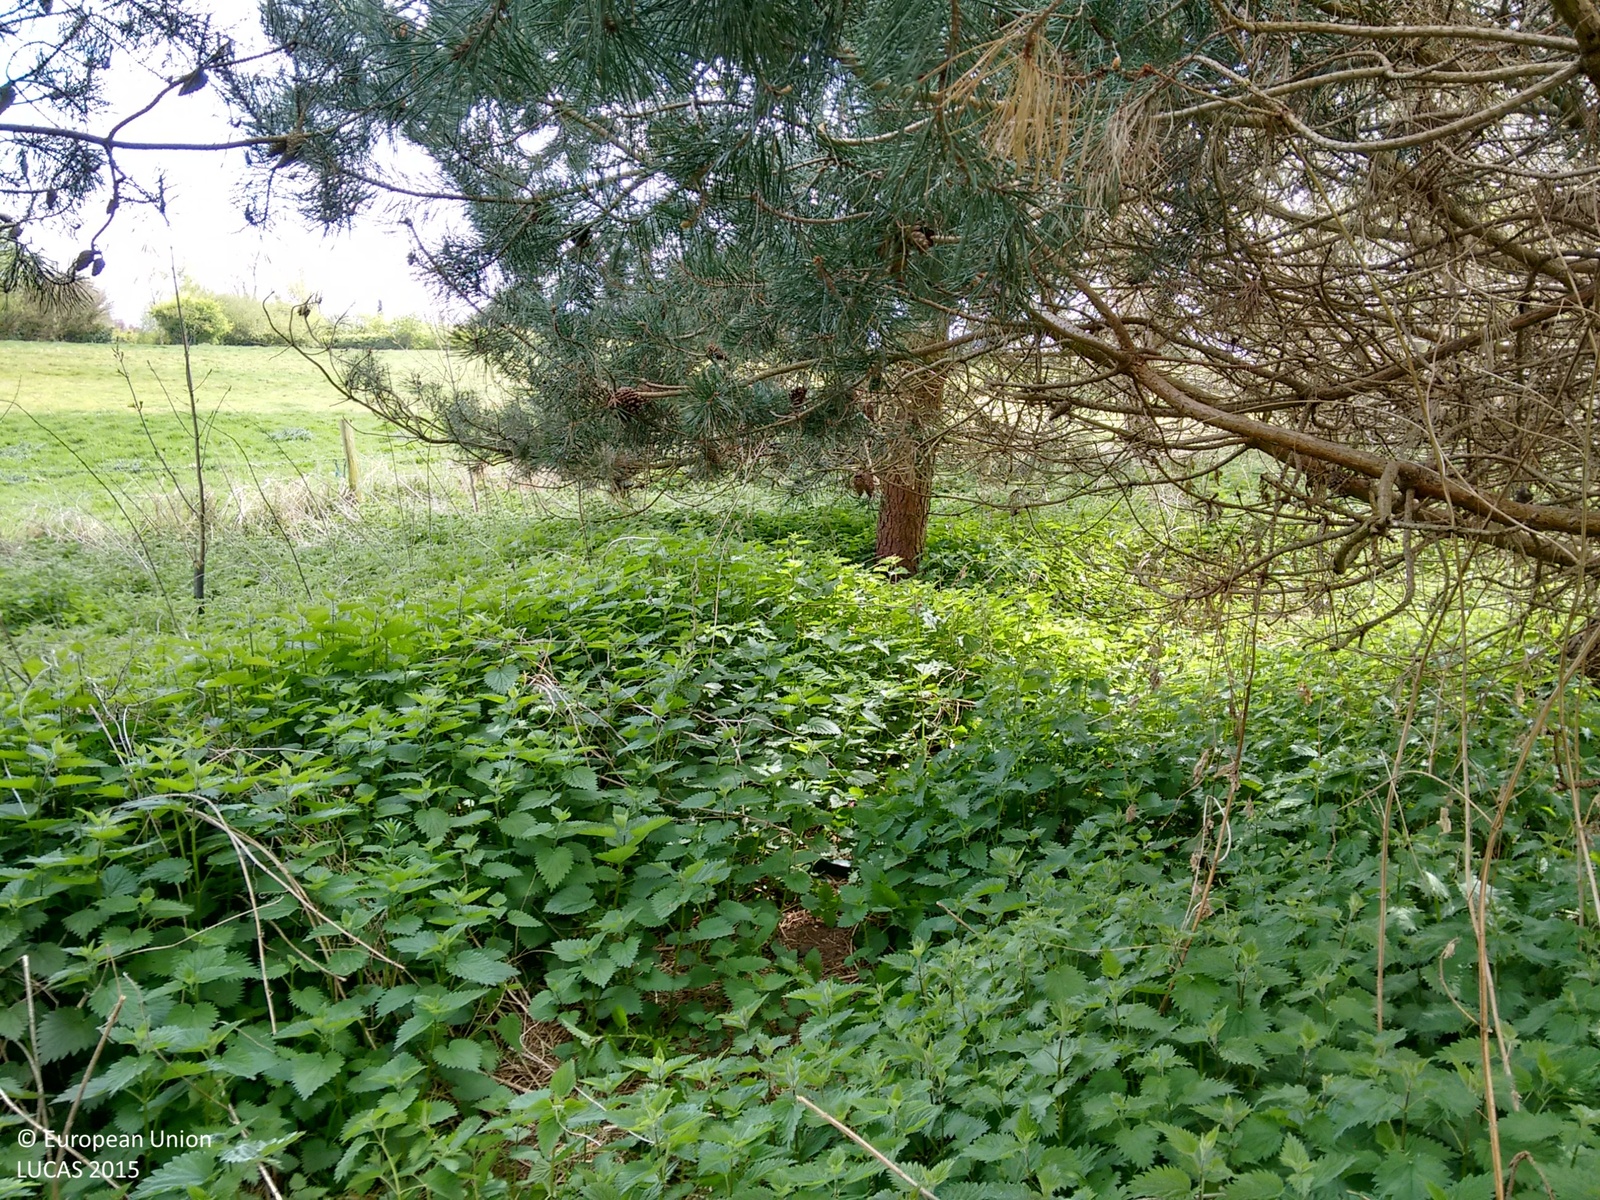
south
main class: Woodland
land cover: Broadleaved woodland
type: mesophytic deciduous forest
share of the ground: > 75 %
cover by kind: broadleaved forest trees 75 %, coniferous forest trees 25 %
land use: Forestry
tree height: > 5 m
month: April
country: GB
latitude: 53.2864
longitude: 0.1142
